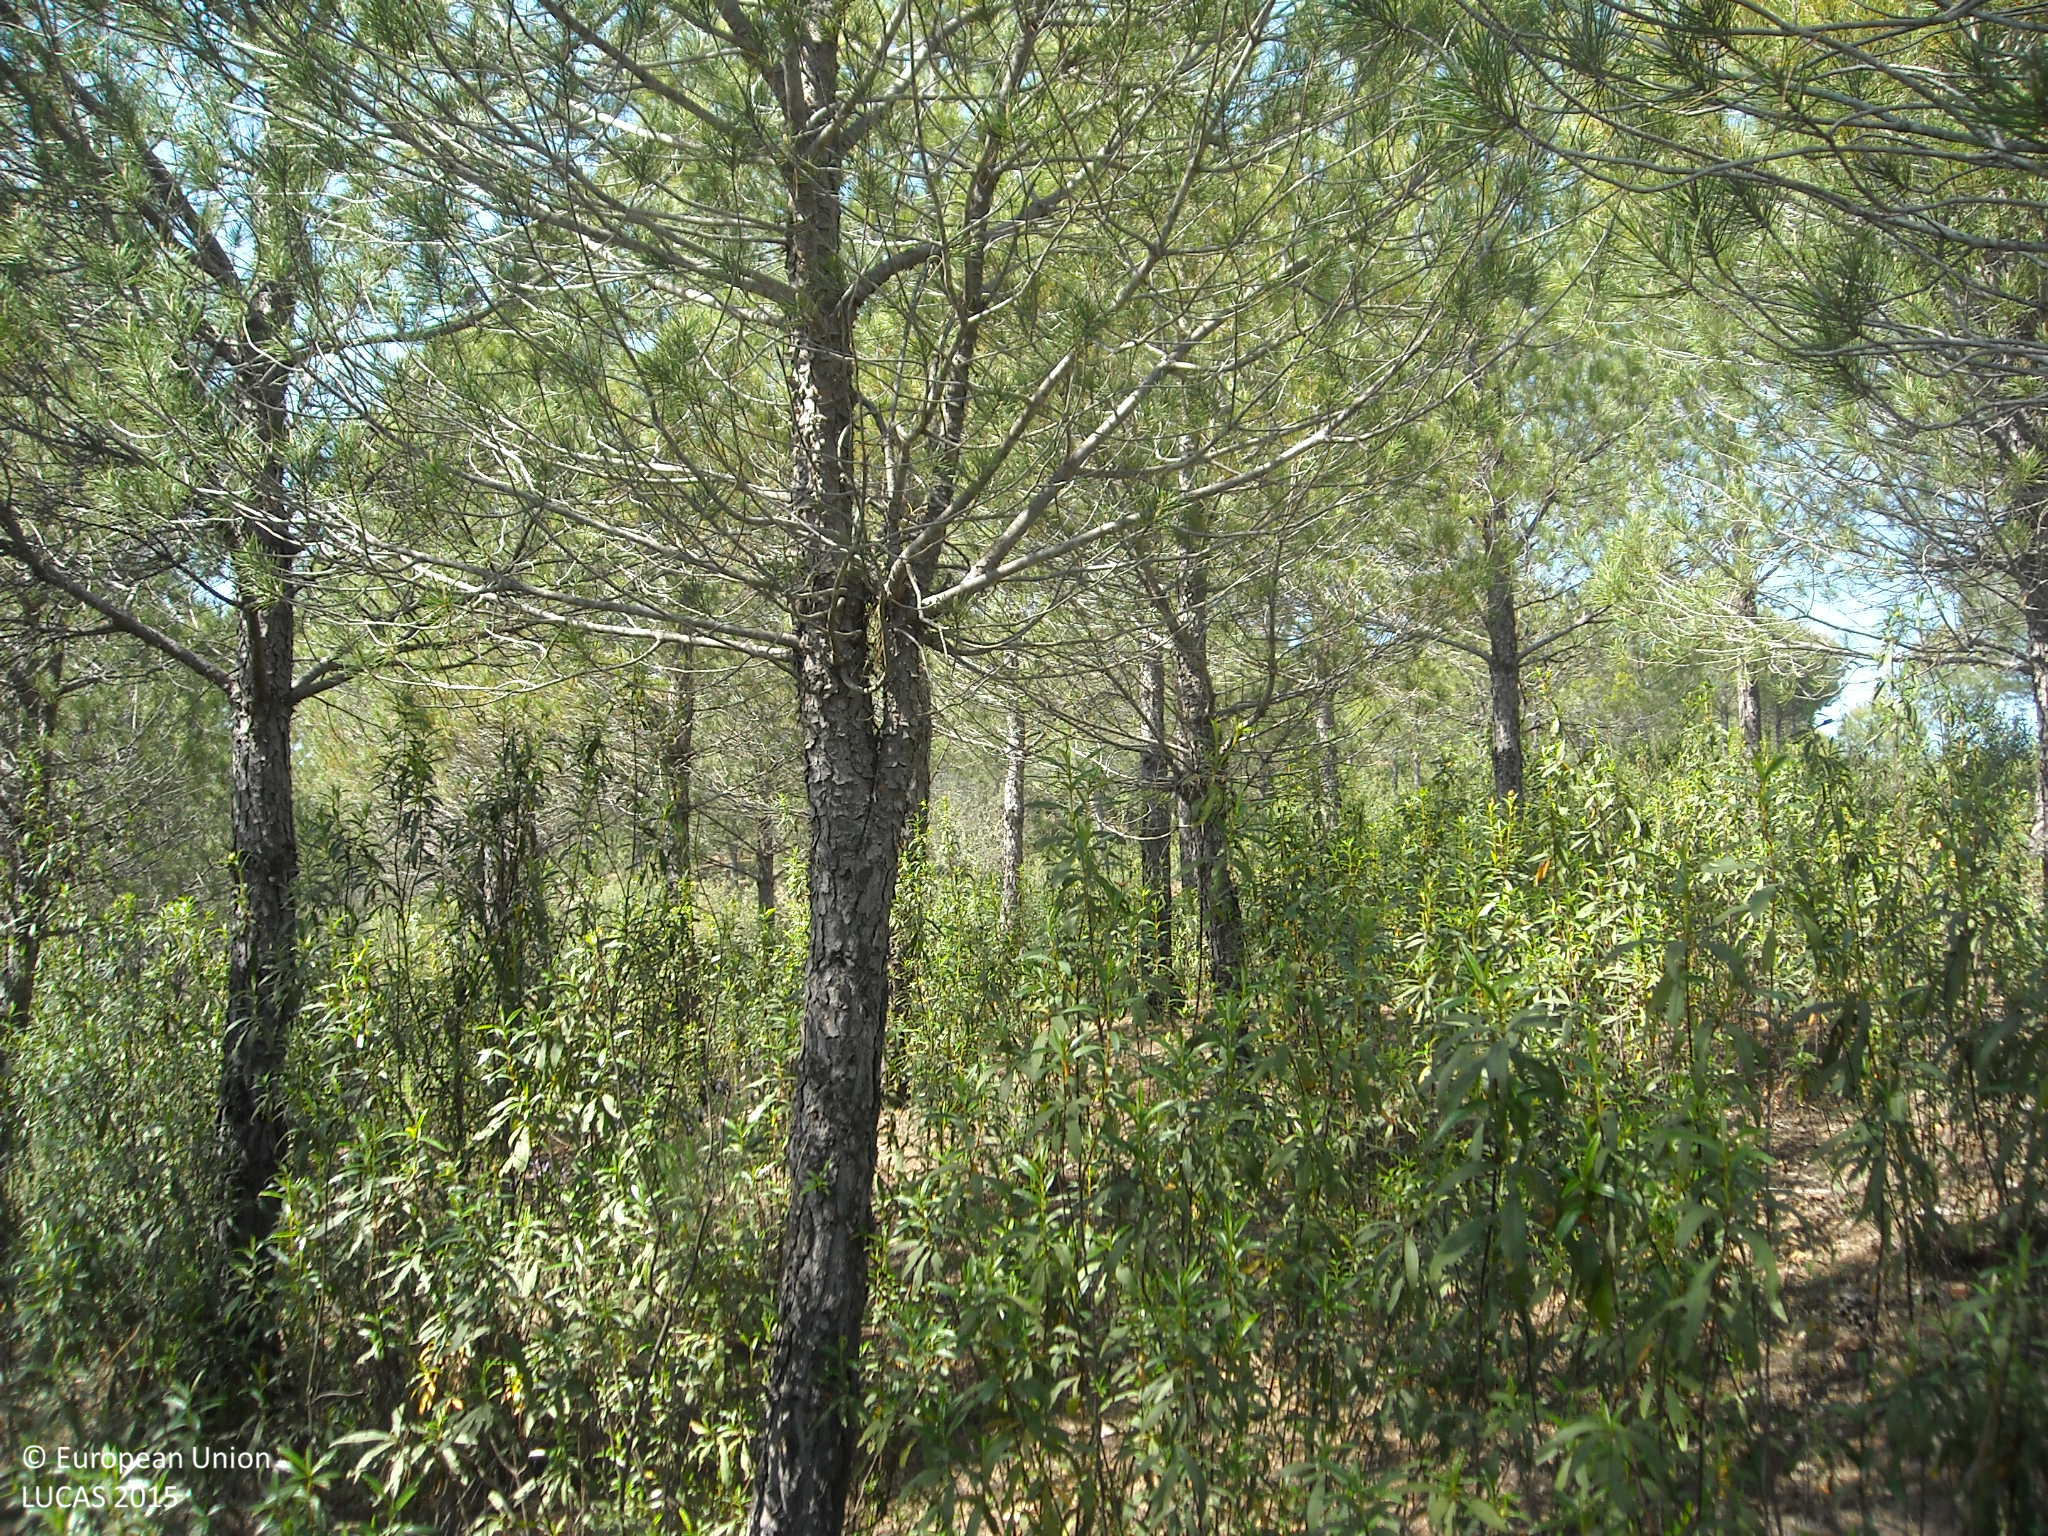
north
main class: Woodland
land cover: Pine dominated coniferous woodland
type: coniferous forest of the mediterranean region
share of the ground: 25 - 50 %
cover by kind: coniferous forest trees 40 %, shrubs 40 %, herbaceous plants 20 %
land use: Forestry
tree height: > 5 m
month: April
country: ES
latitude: 37.7027
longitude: -6.4730
